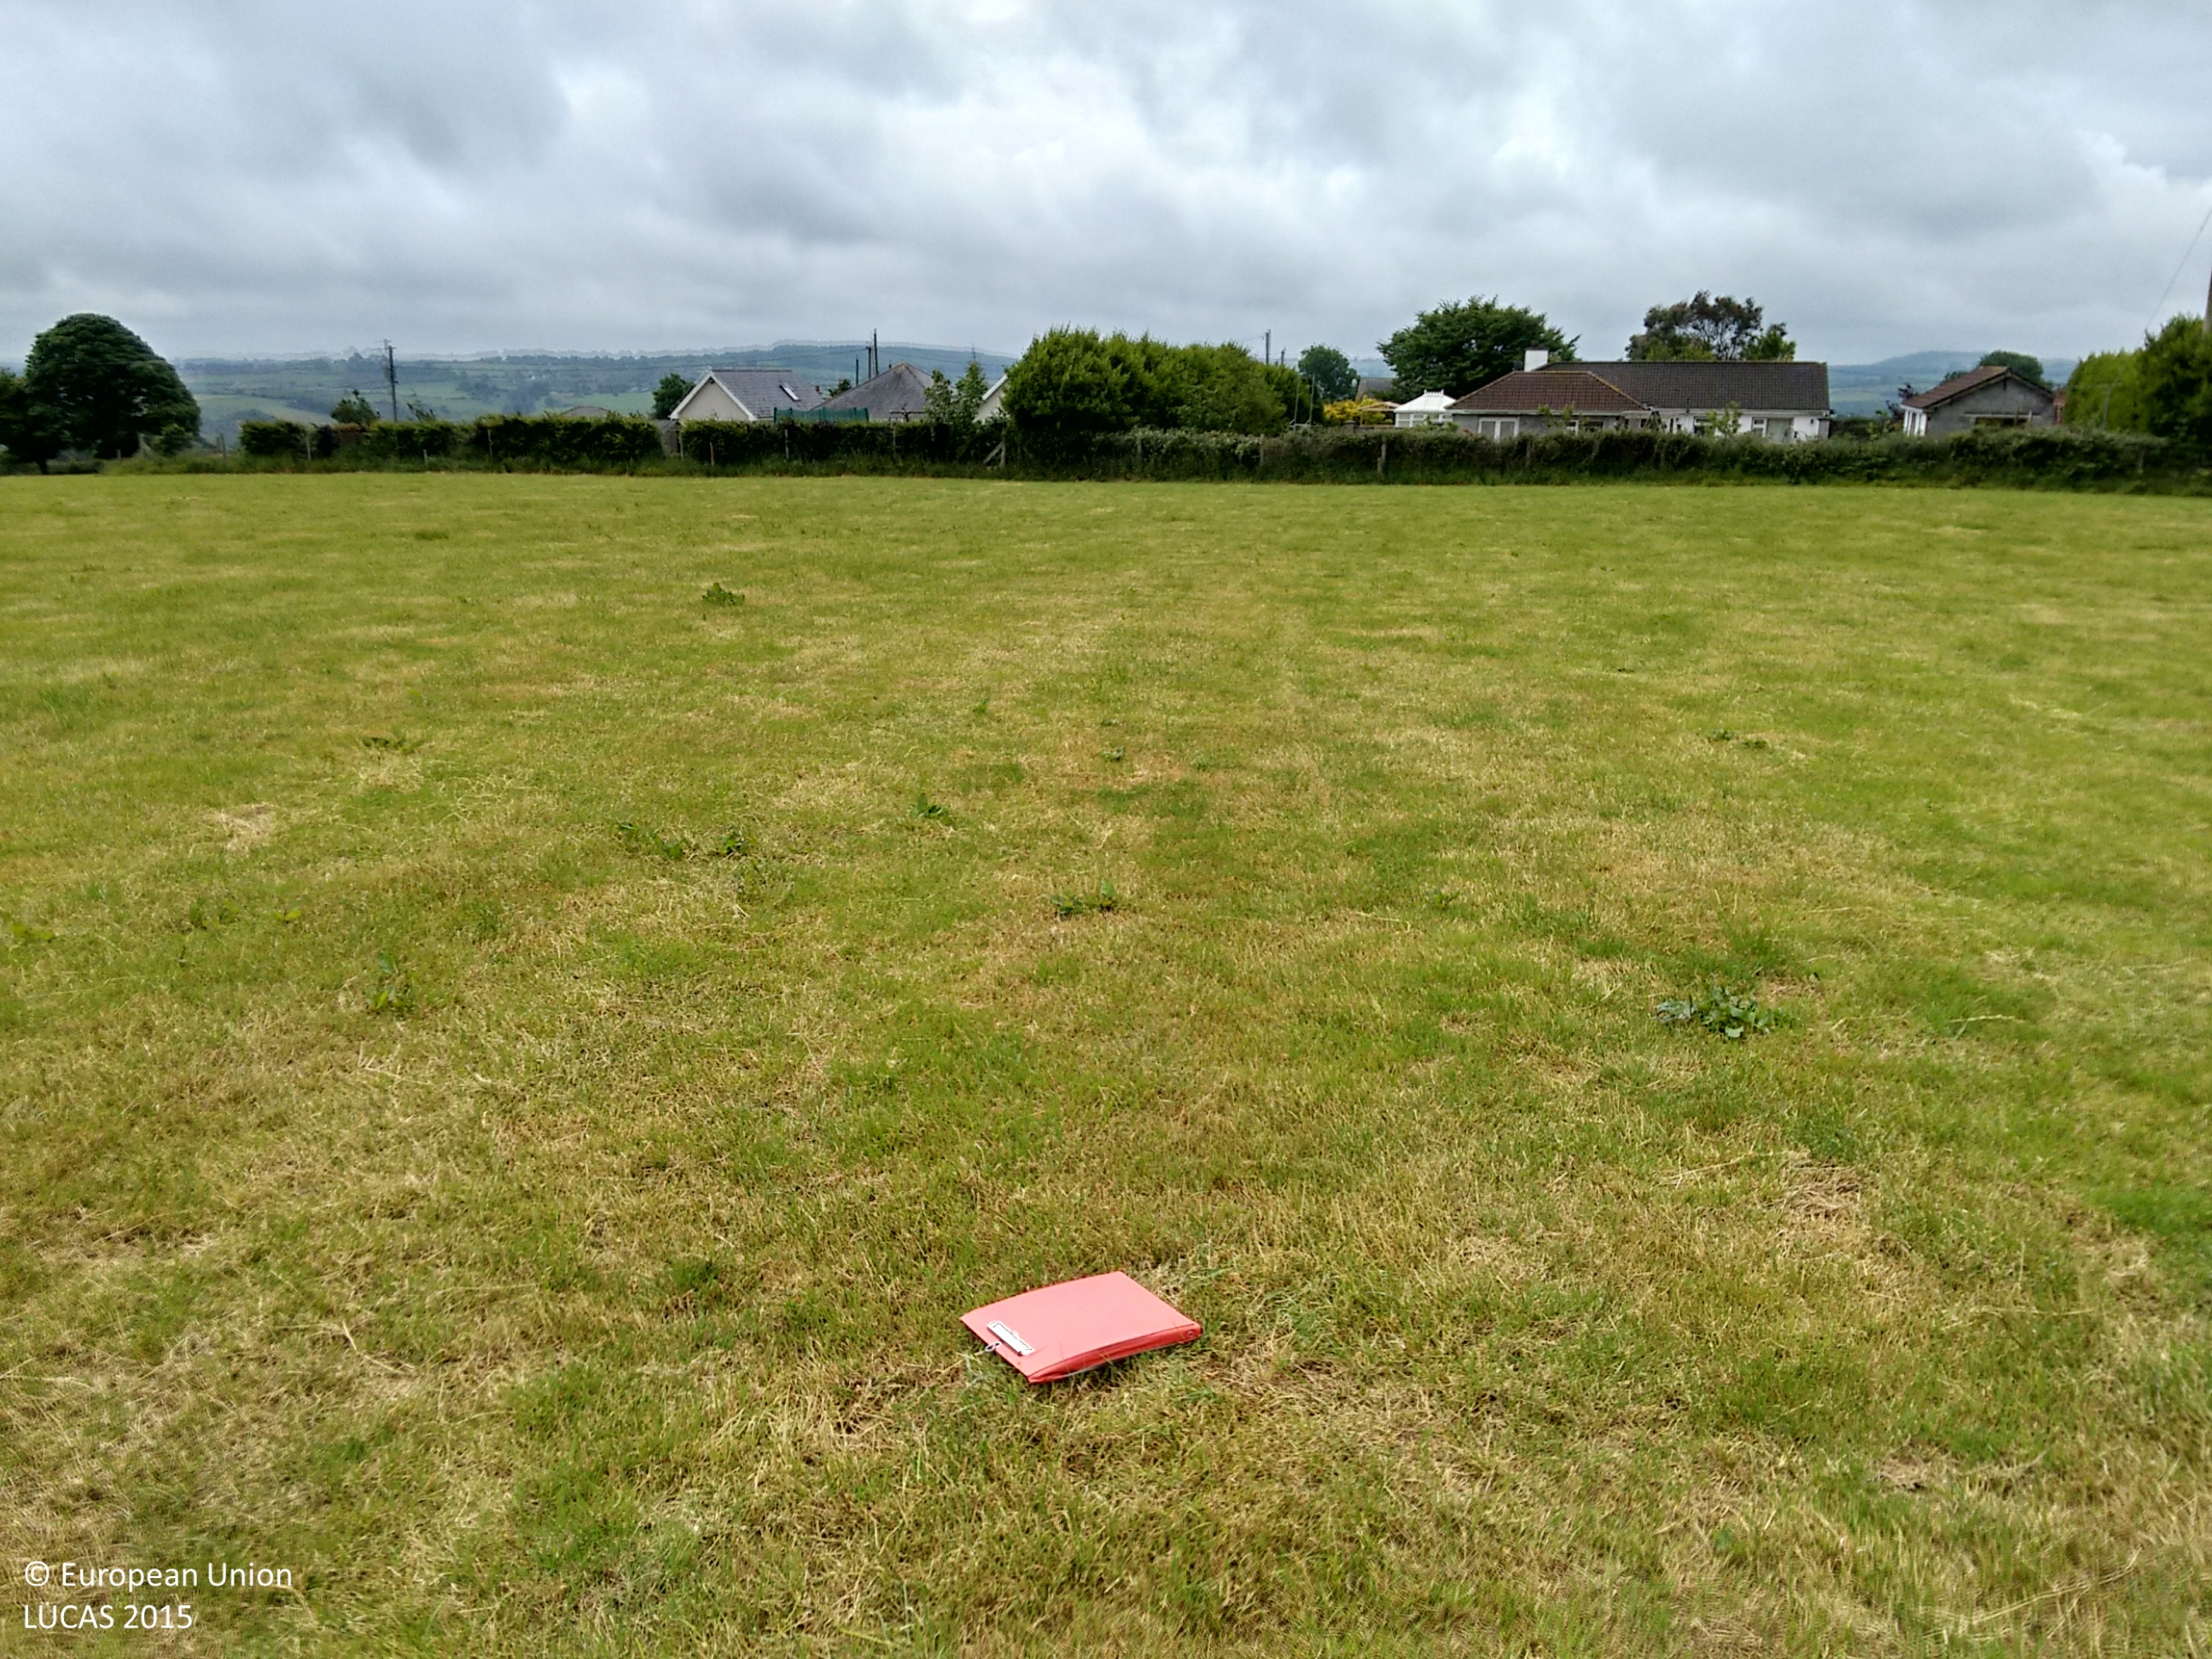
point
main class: Grassland
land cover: Grassland without tree/shrub cover
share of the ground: > 75 %
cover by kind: herbaceous plants 100 %
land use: Agriculture (excluding fallow land and kitchen gardens)
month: June
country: IE
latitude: 52.2521
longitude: -7.3060
